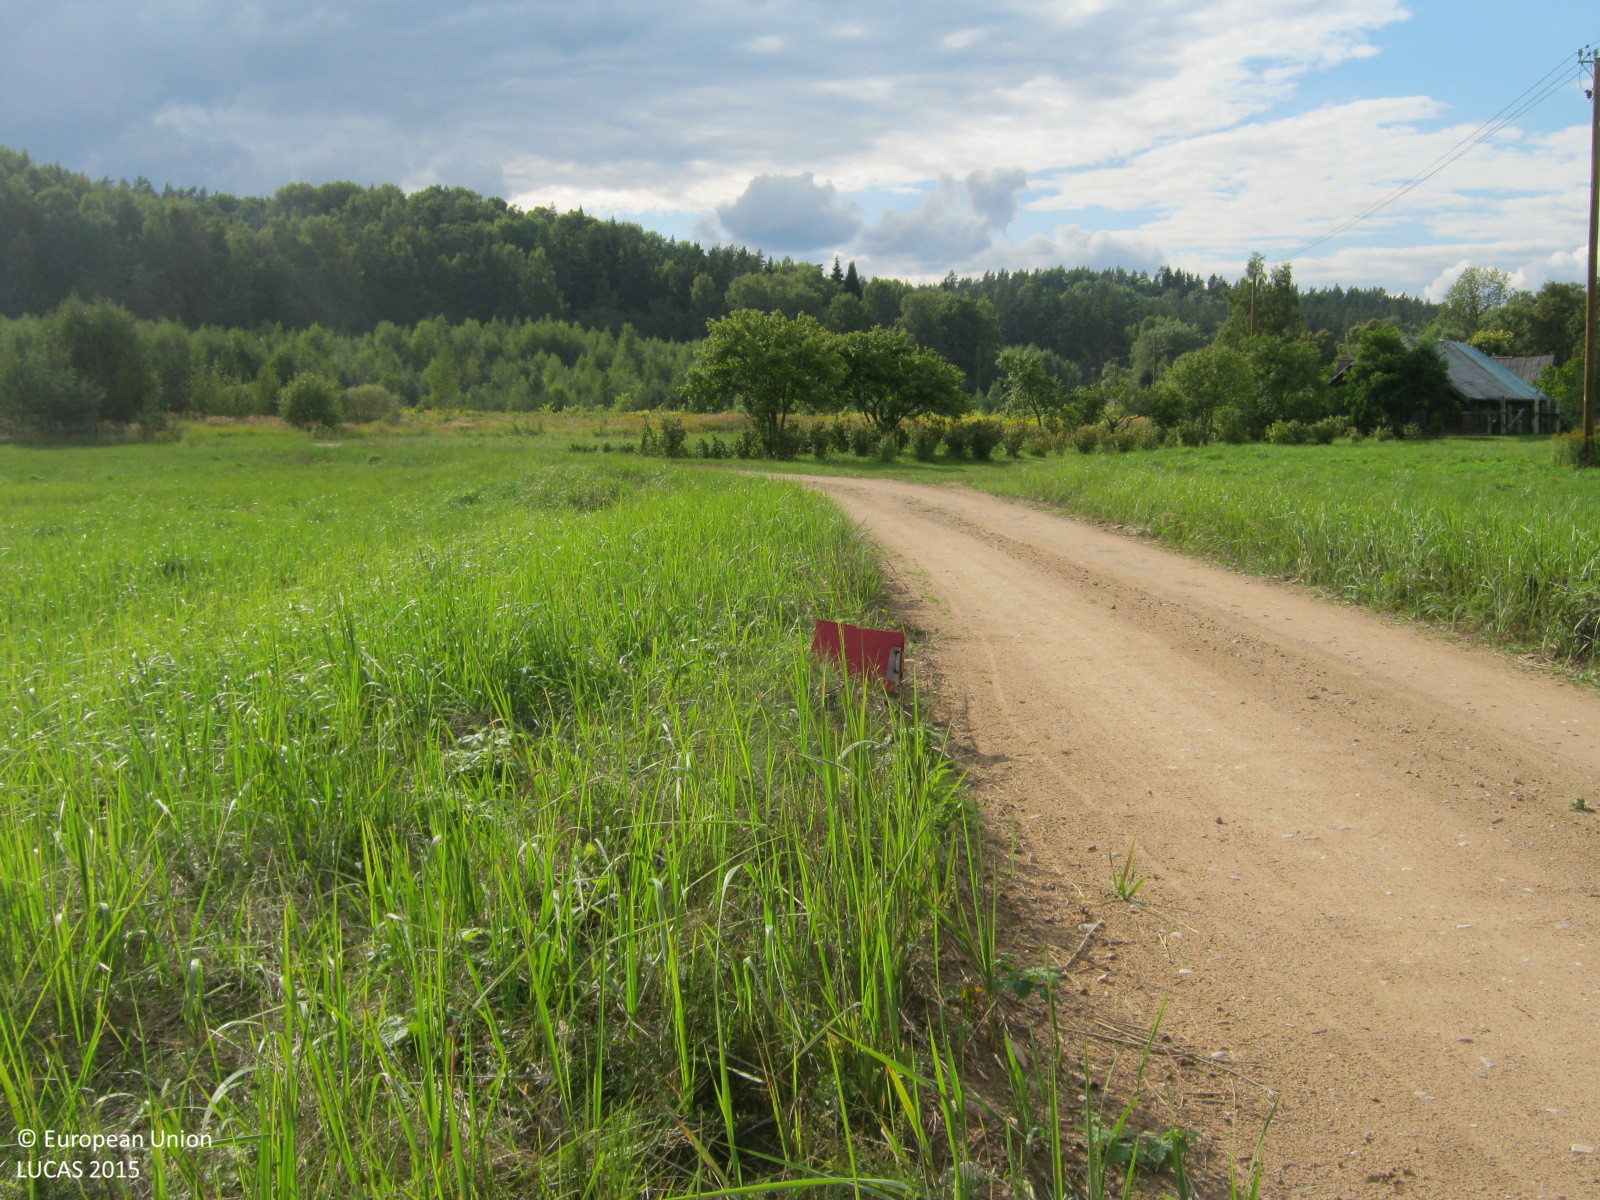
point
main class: Grassland
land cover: Grassland without tree/shrub cover
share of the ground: > 75 %
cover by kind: herbaceous plants 100 %
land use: Agriculture (excluding fallow land and kitchen gardens)
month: September
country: LV
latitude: 57.2719
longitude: 25.2171
